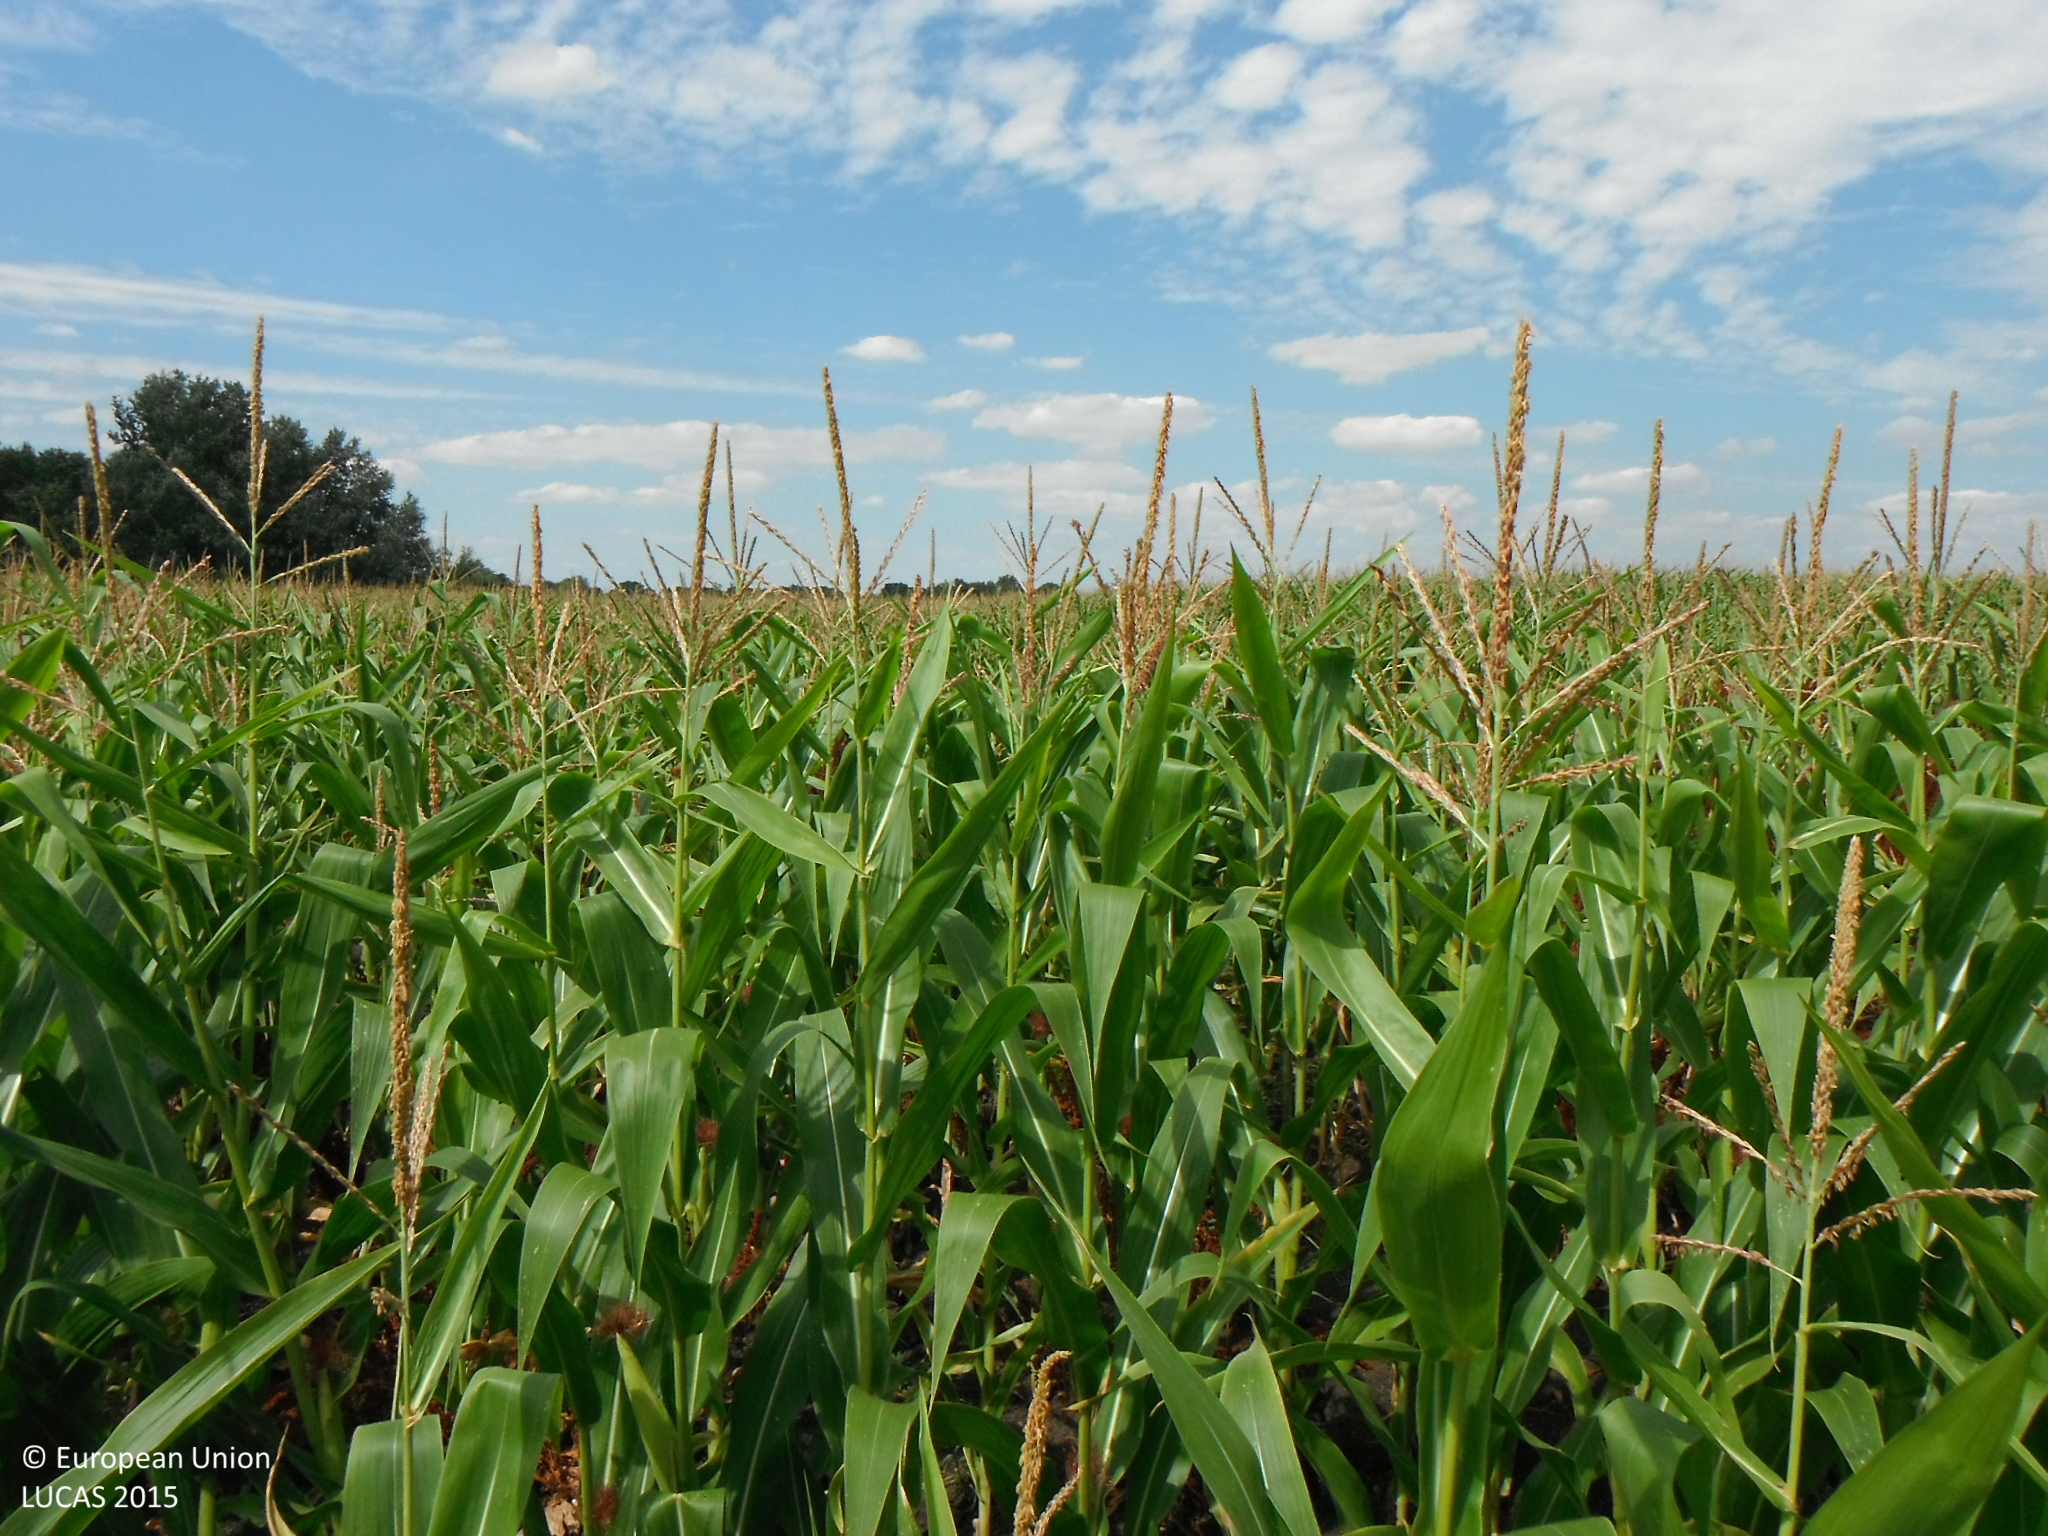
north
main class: Cropland
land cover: Maize
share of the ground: > 75 %
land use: Agriculture (excluding fallow land and kitchen gardens)
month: July
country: SK
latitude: 48.1151
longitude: 18.2212
